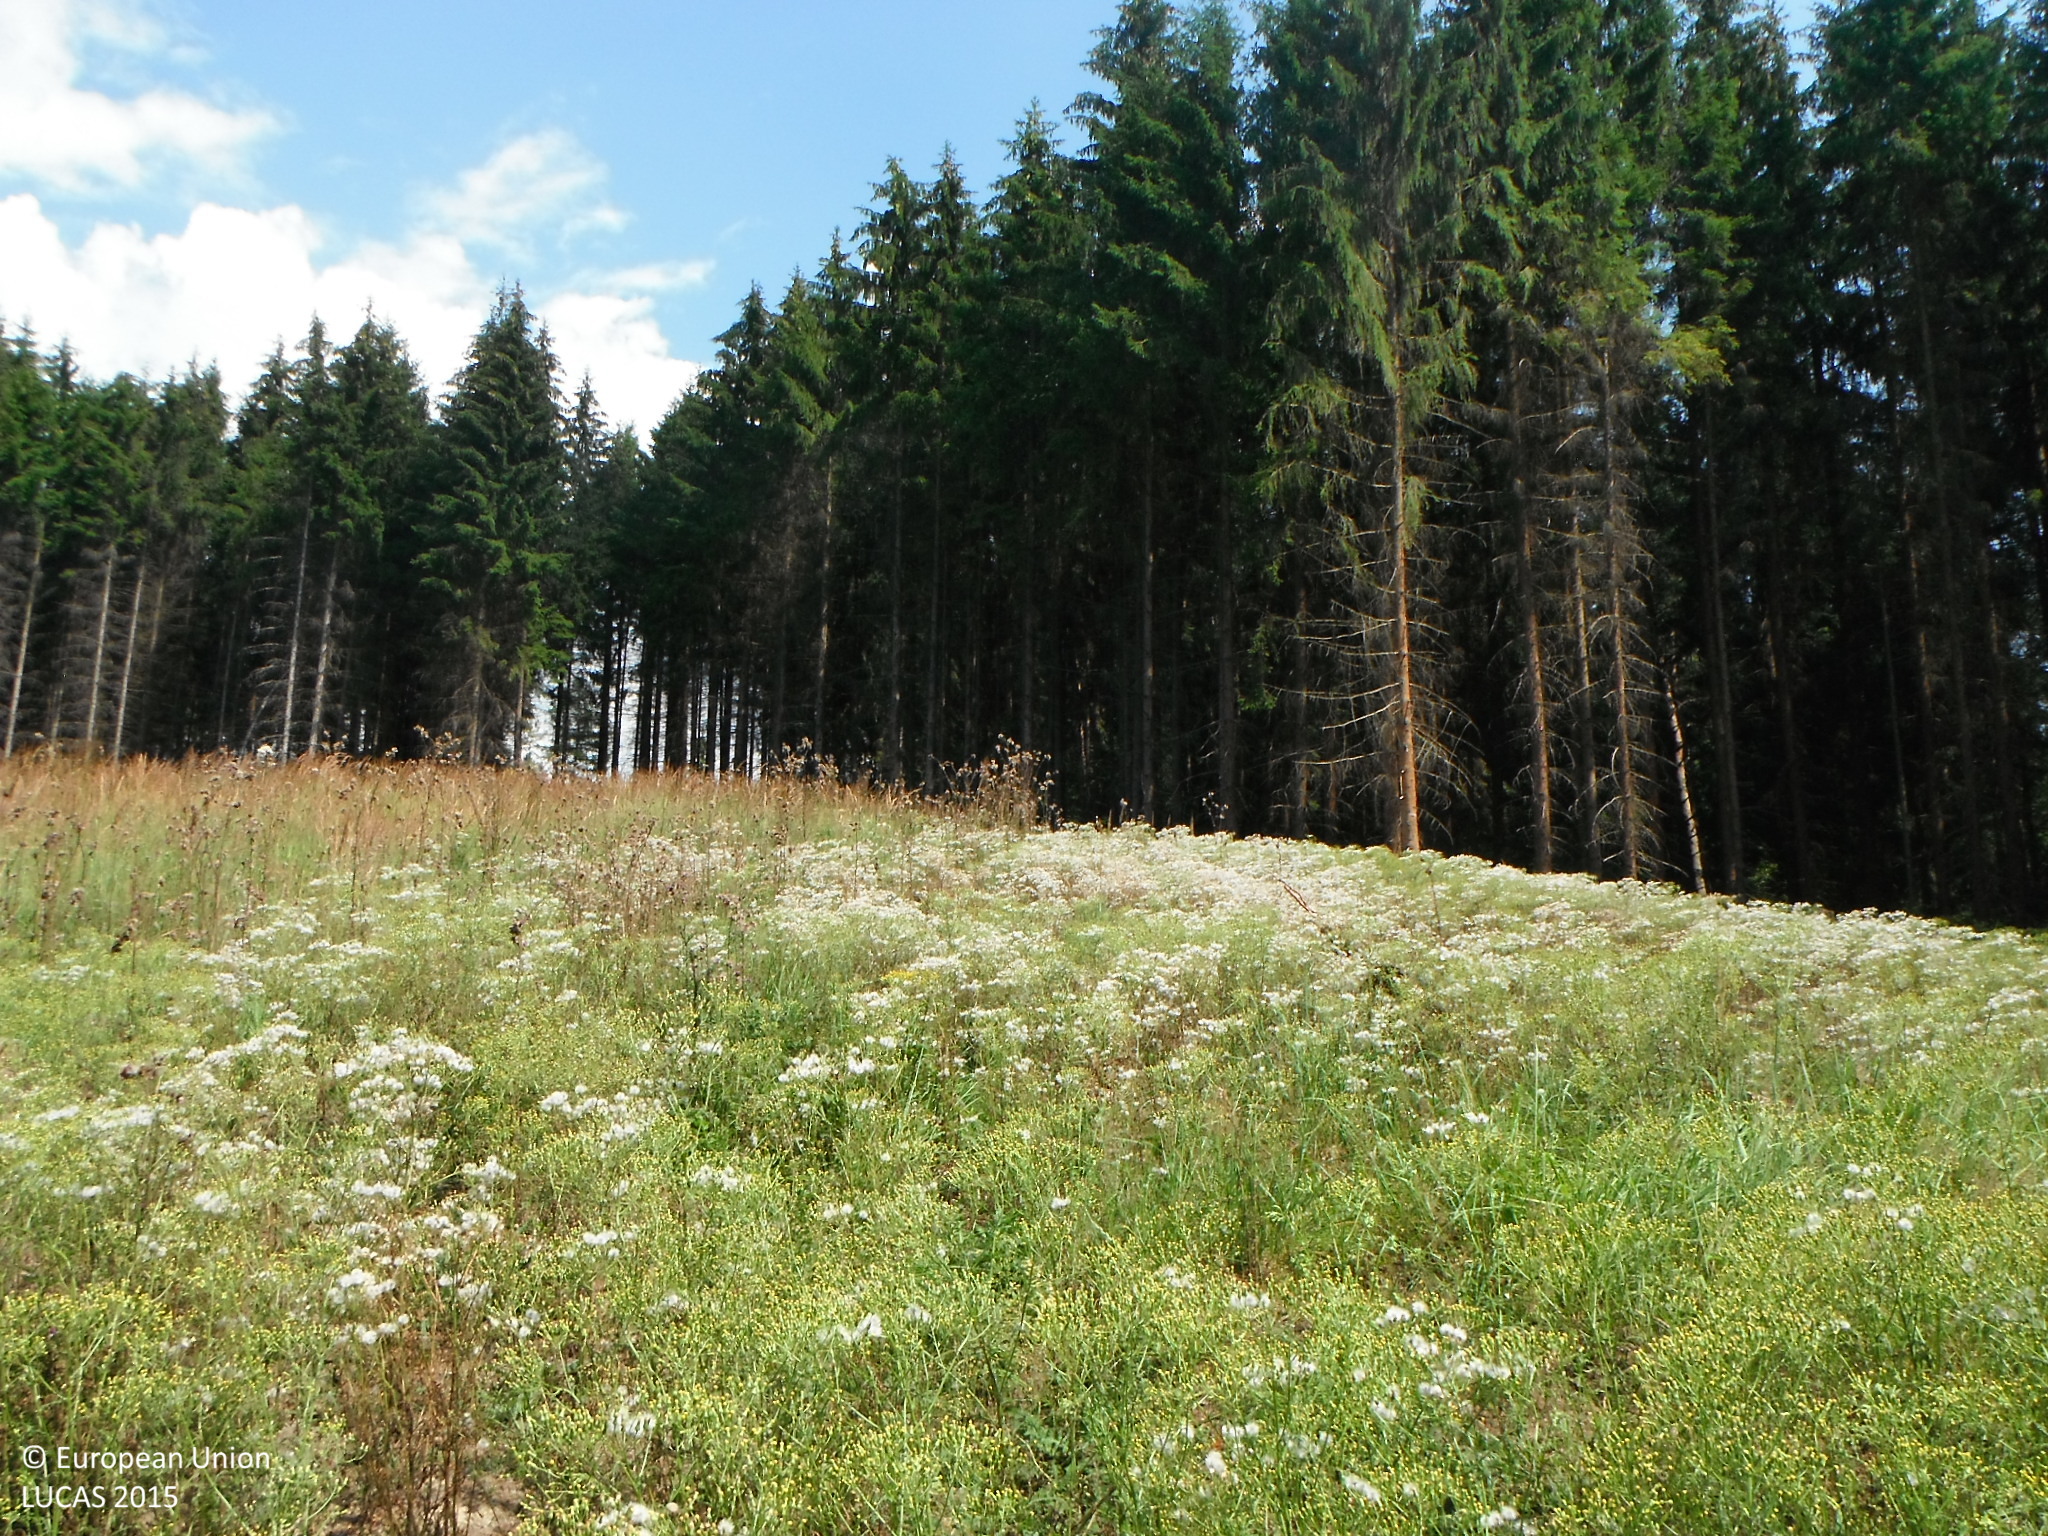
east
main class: Grassland
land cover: Spontaneously vegetated surfaces
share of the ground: > 75 %
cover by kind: herbaceous plants 100 %
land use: Forestry
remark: Clear cut
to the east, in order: Spontaneously vegetated surfaces; Tracks; Spruce dominated coniferous woodland; Spontaneously vegetated surfaces; Spruce dominated coniferous woodland
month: August
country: SK
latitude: 49.3536
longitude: 18.8177
